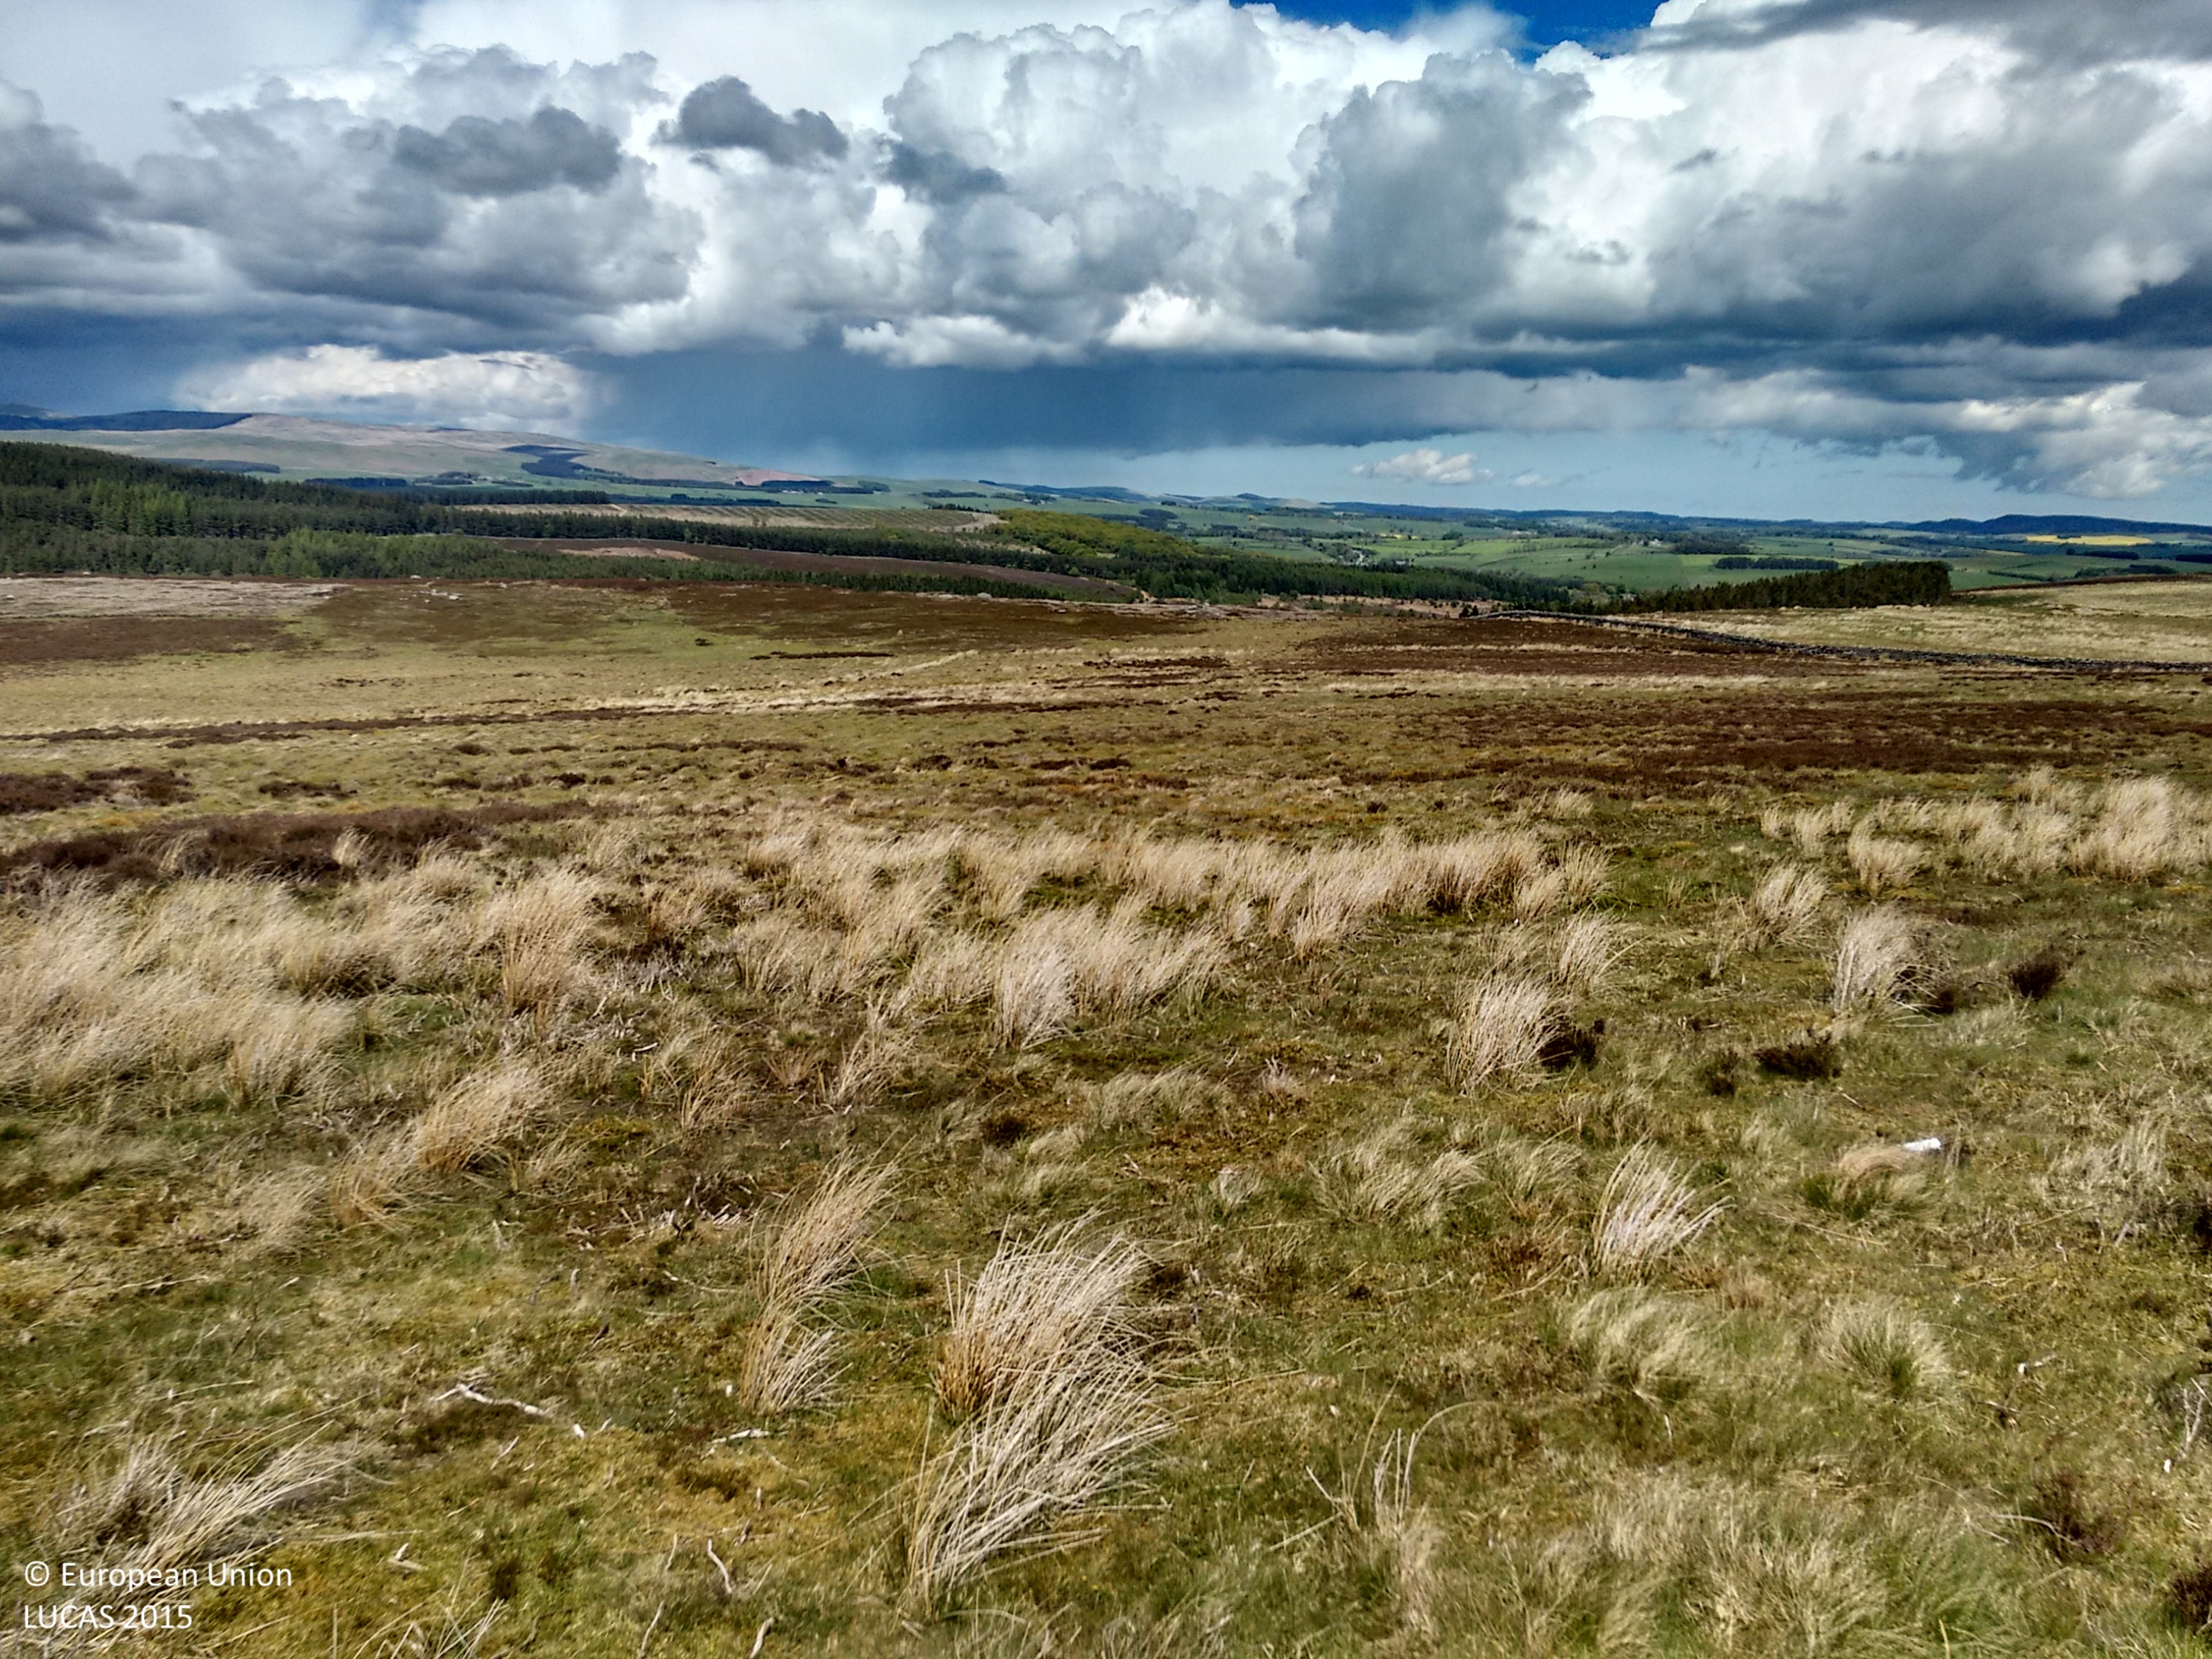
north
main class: Shrubland
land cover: Shrubland without tree cover
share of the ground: > 75 %
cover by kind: shrubs 80 %, herbaceous plants 20 %
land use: Agriculture (excluding fallow land and kitchen gardens)
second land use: Community services
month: May
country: GB
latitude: 55.3027
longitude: -2.1055
